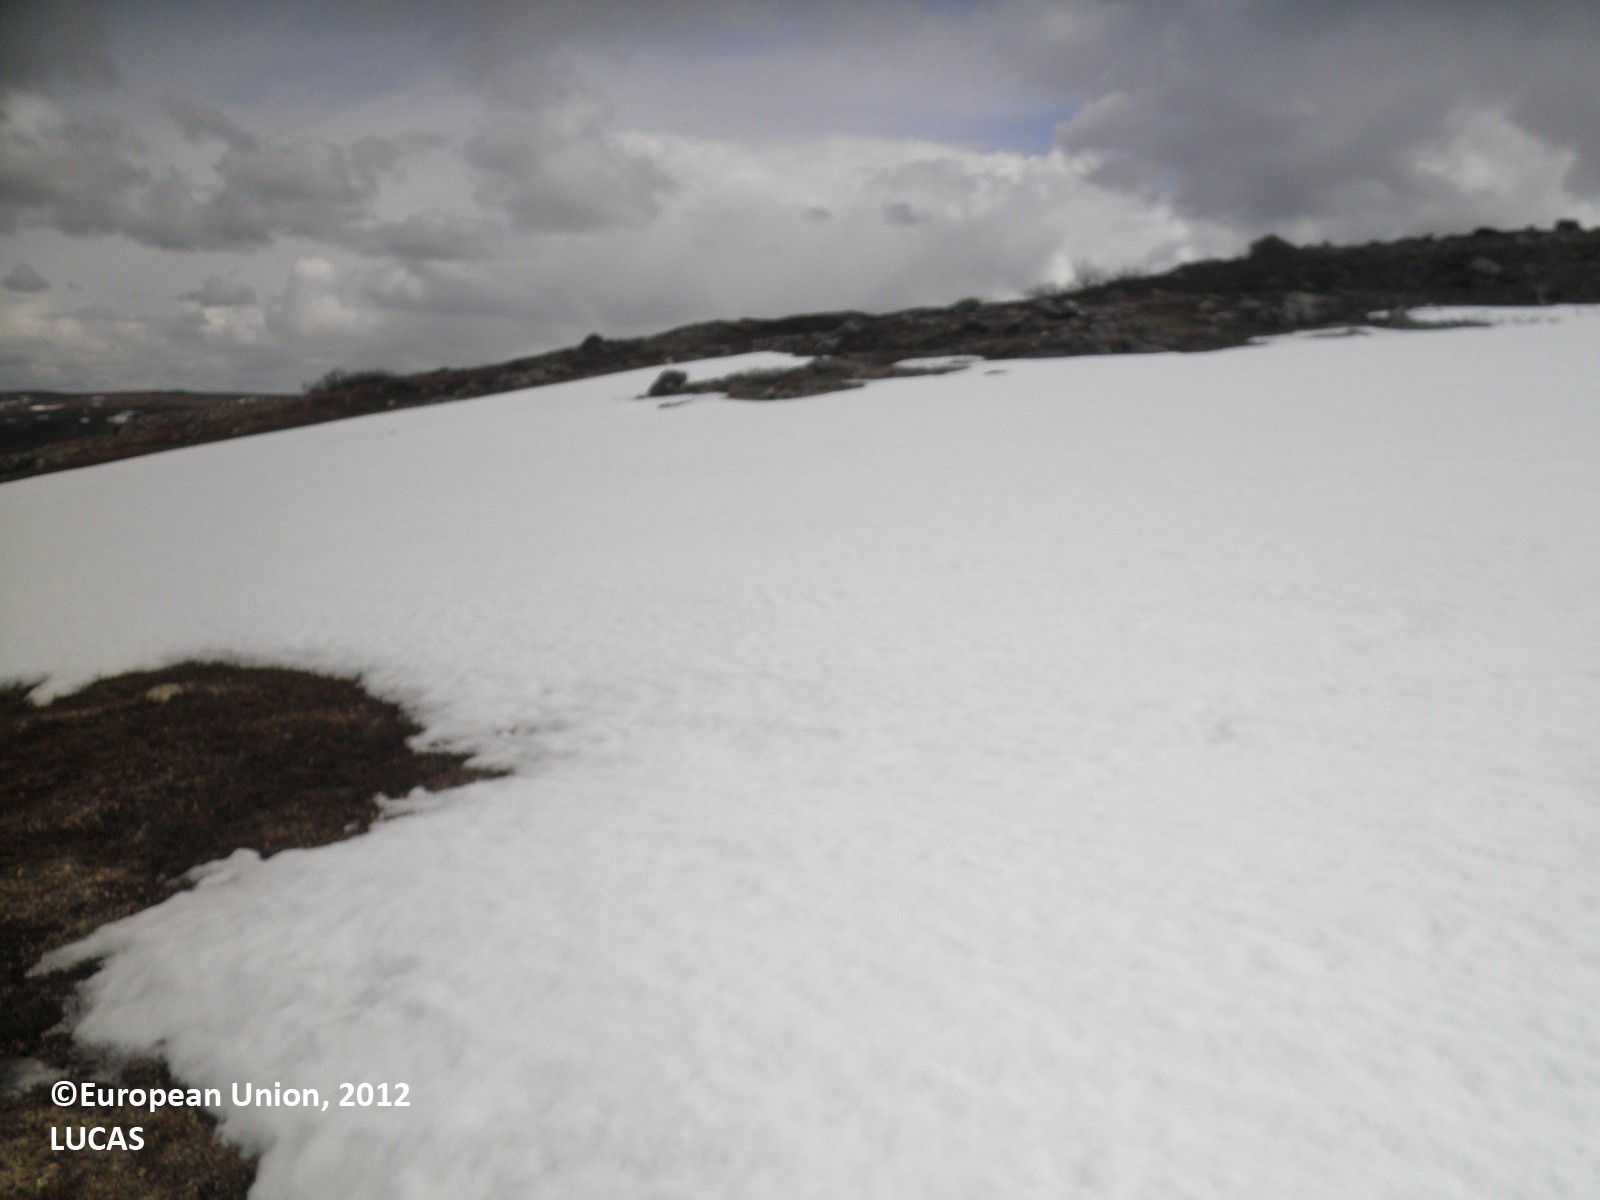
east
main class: Shrubland
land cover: Shrubland without tree cover
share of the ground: > 75 %
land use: Semi-natural and natural areas not in use
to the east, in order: Shrubland without tree cover
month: May
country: FI
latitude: 69.8993
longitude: 27.0673
